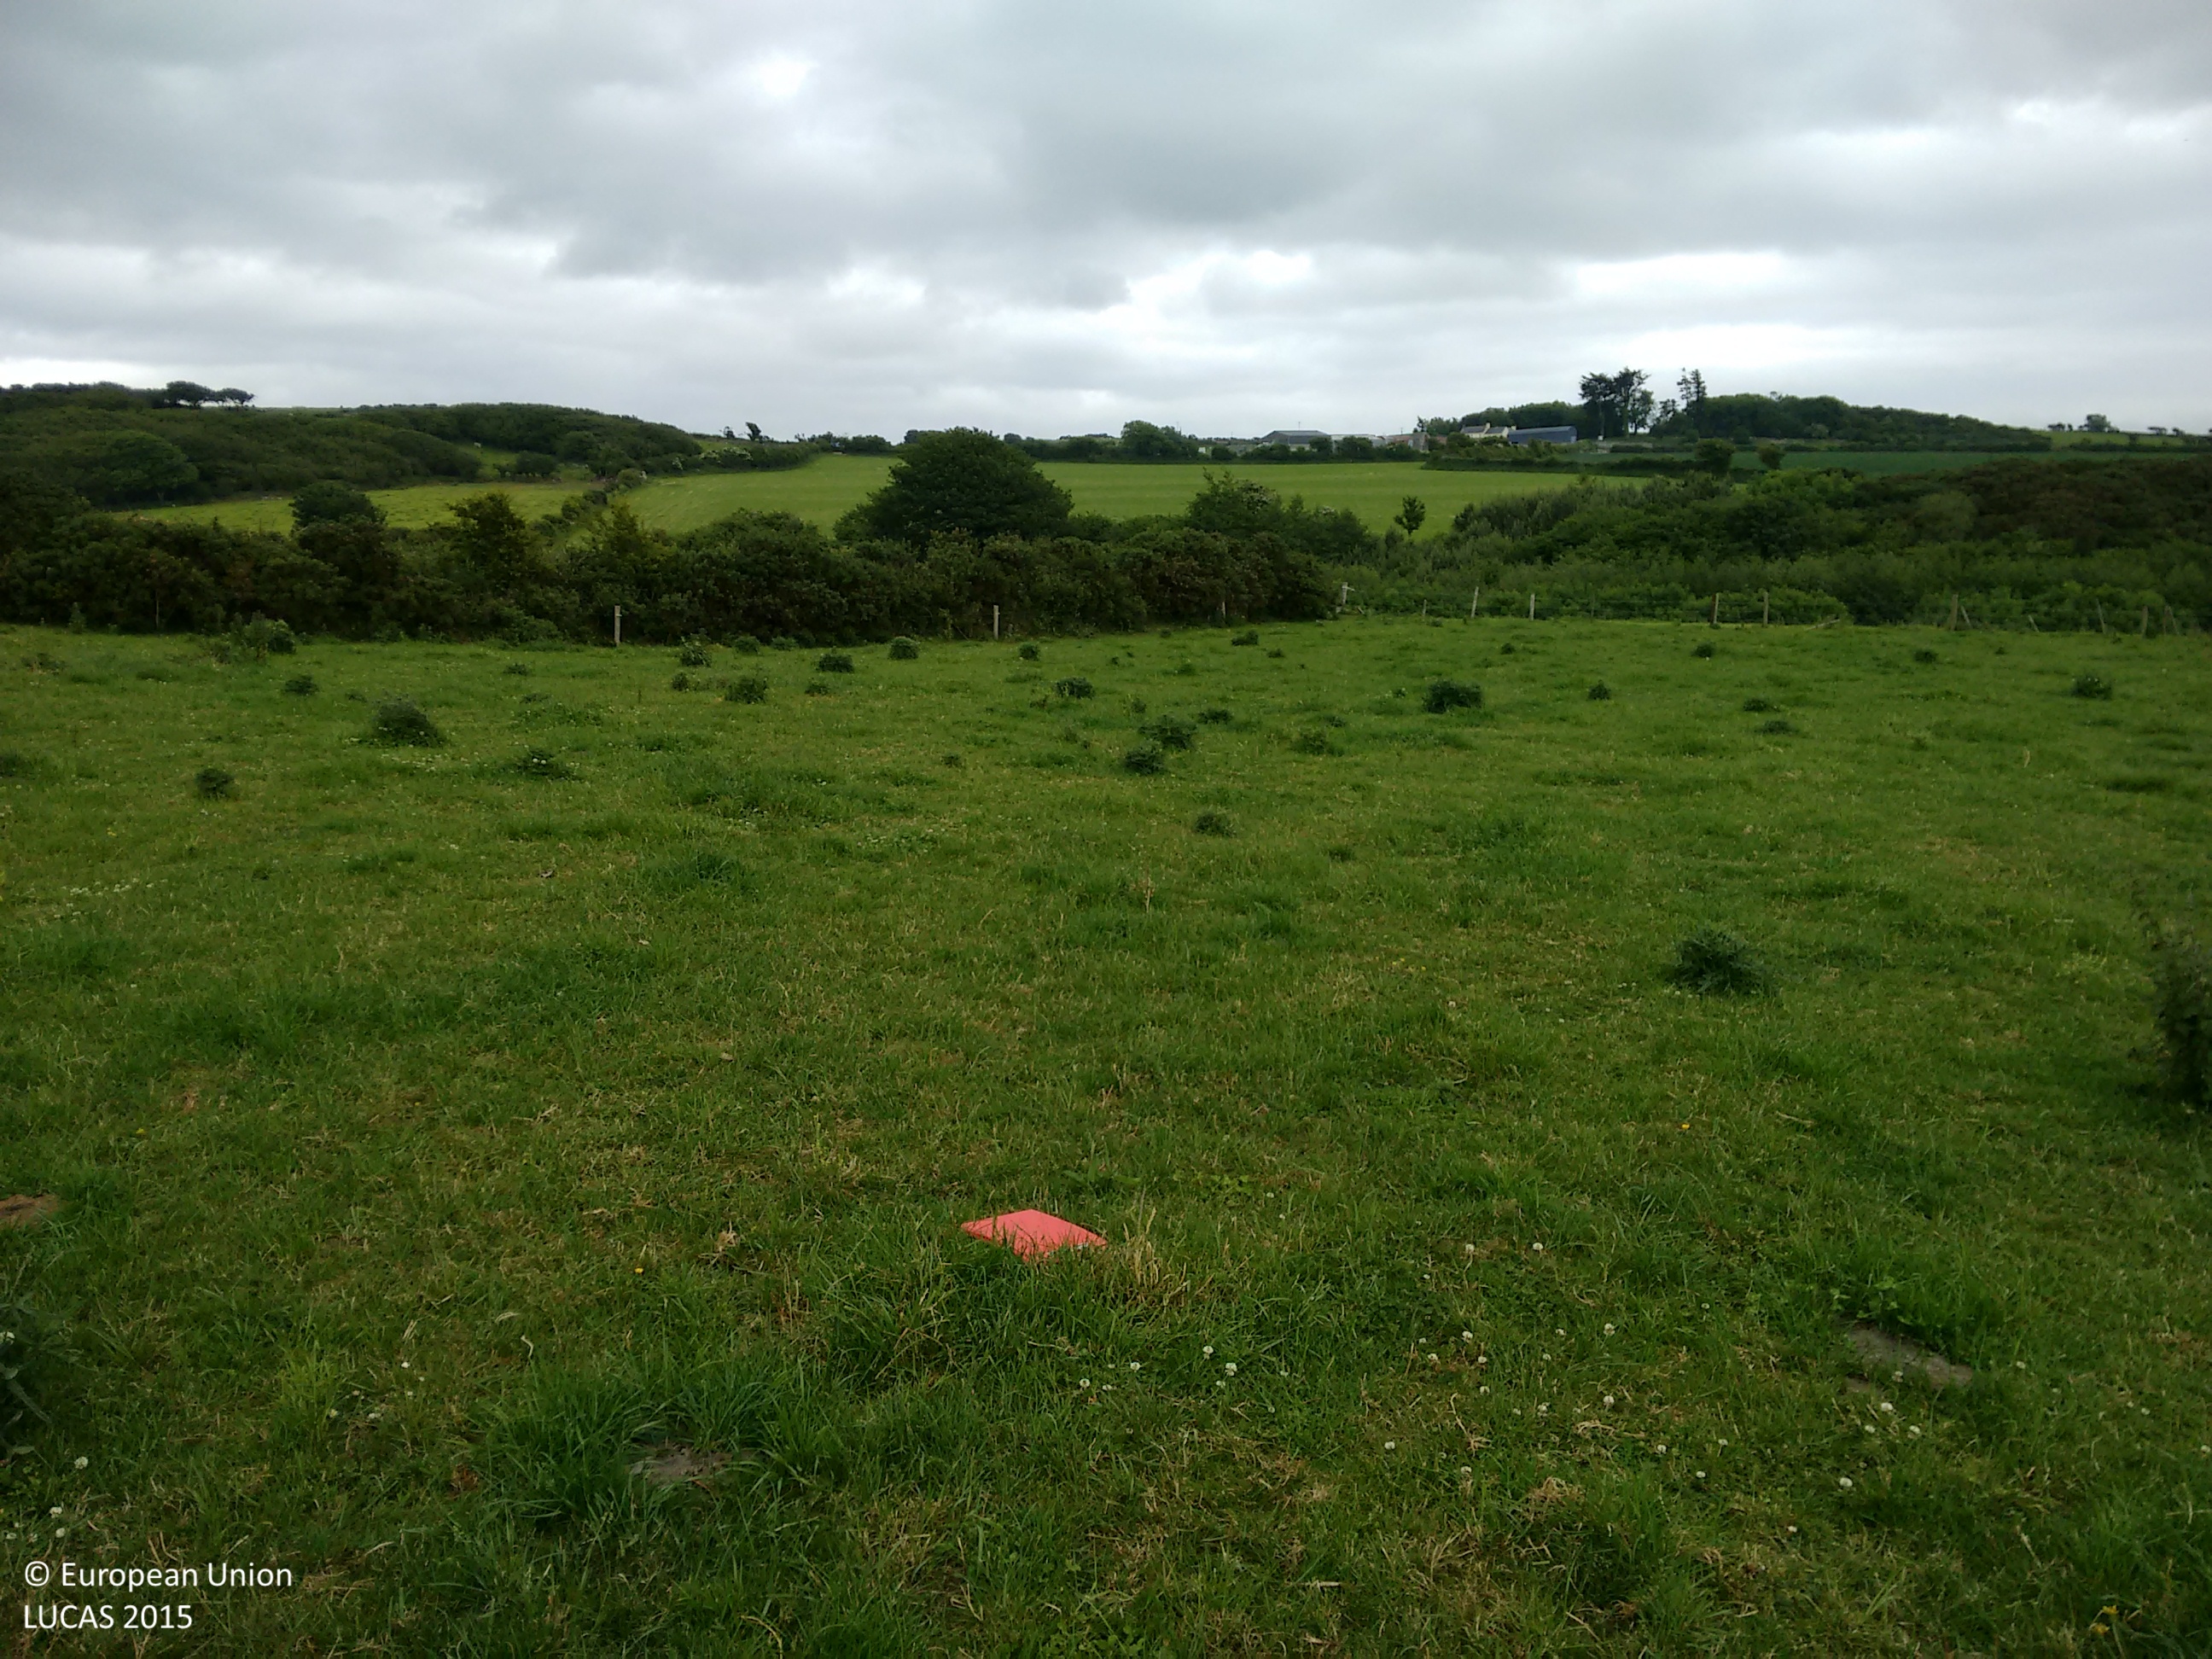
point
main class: Grassland
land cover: Grassland without tree/shrub cover
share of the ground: > 75 %
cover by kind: herbaceous plants 100 %
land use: Agriculture (excluding fallow land and kitchen gardens)
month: June
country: IE
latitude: 52.1868
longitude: -7.2498
